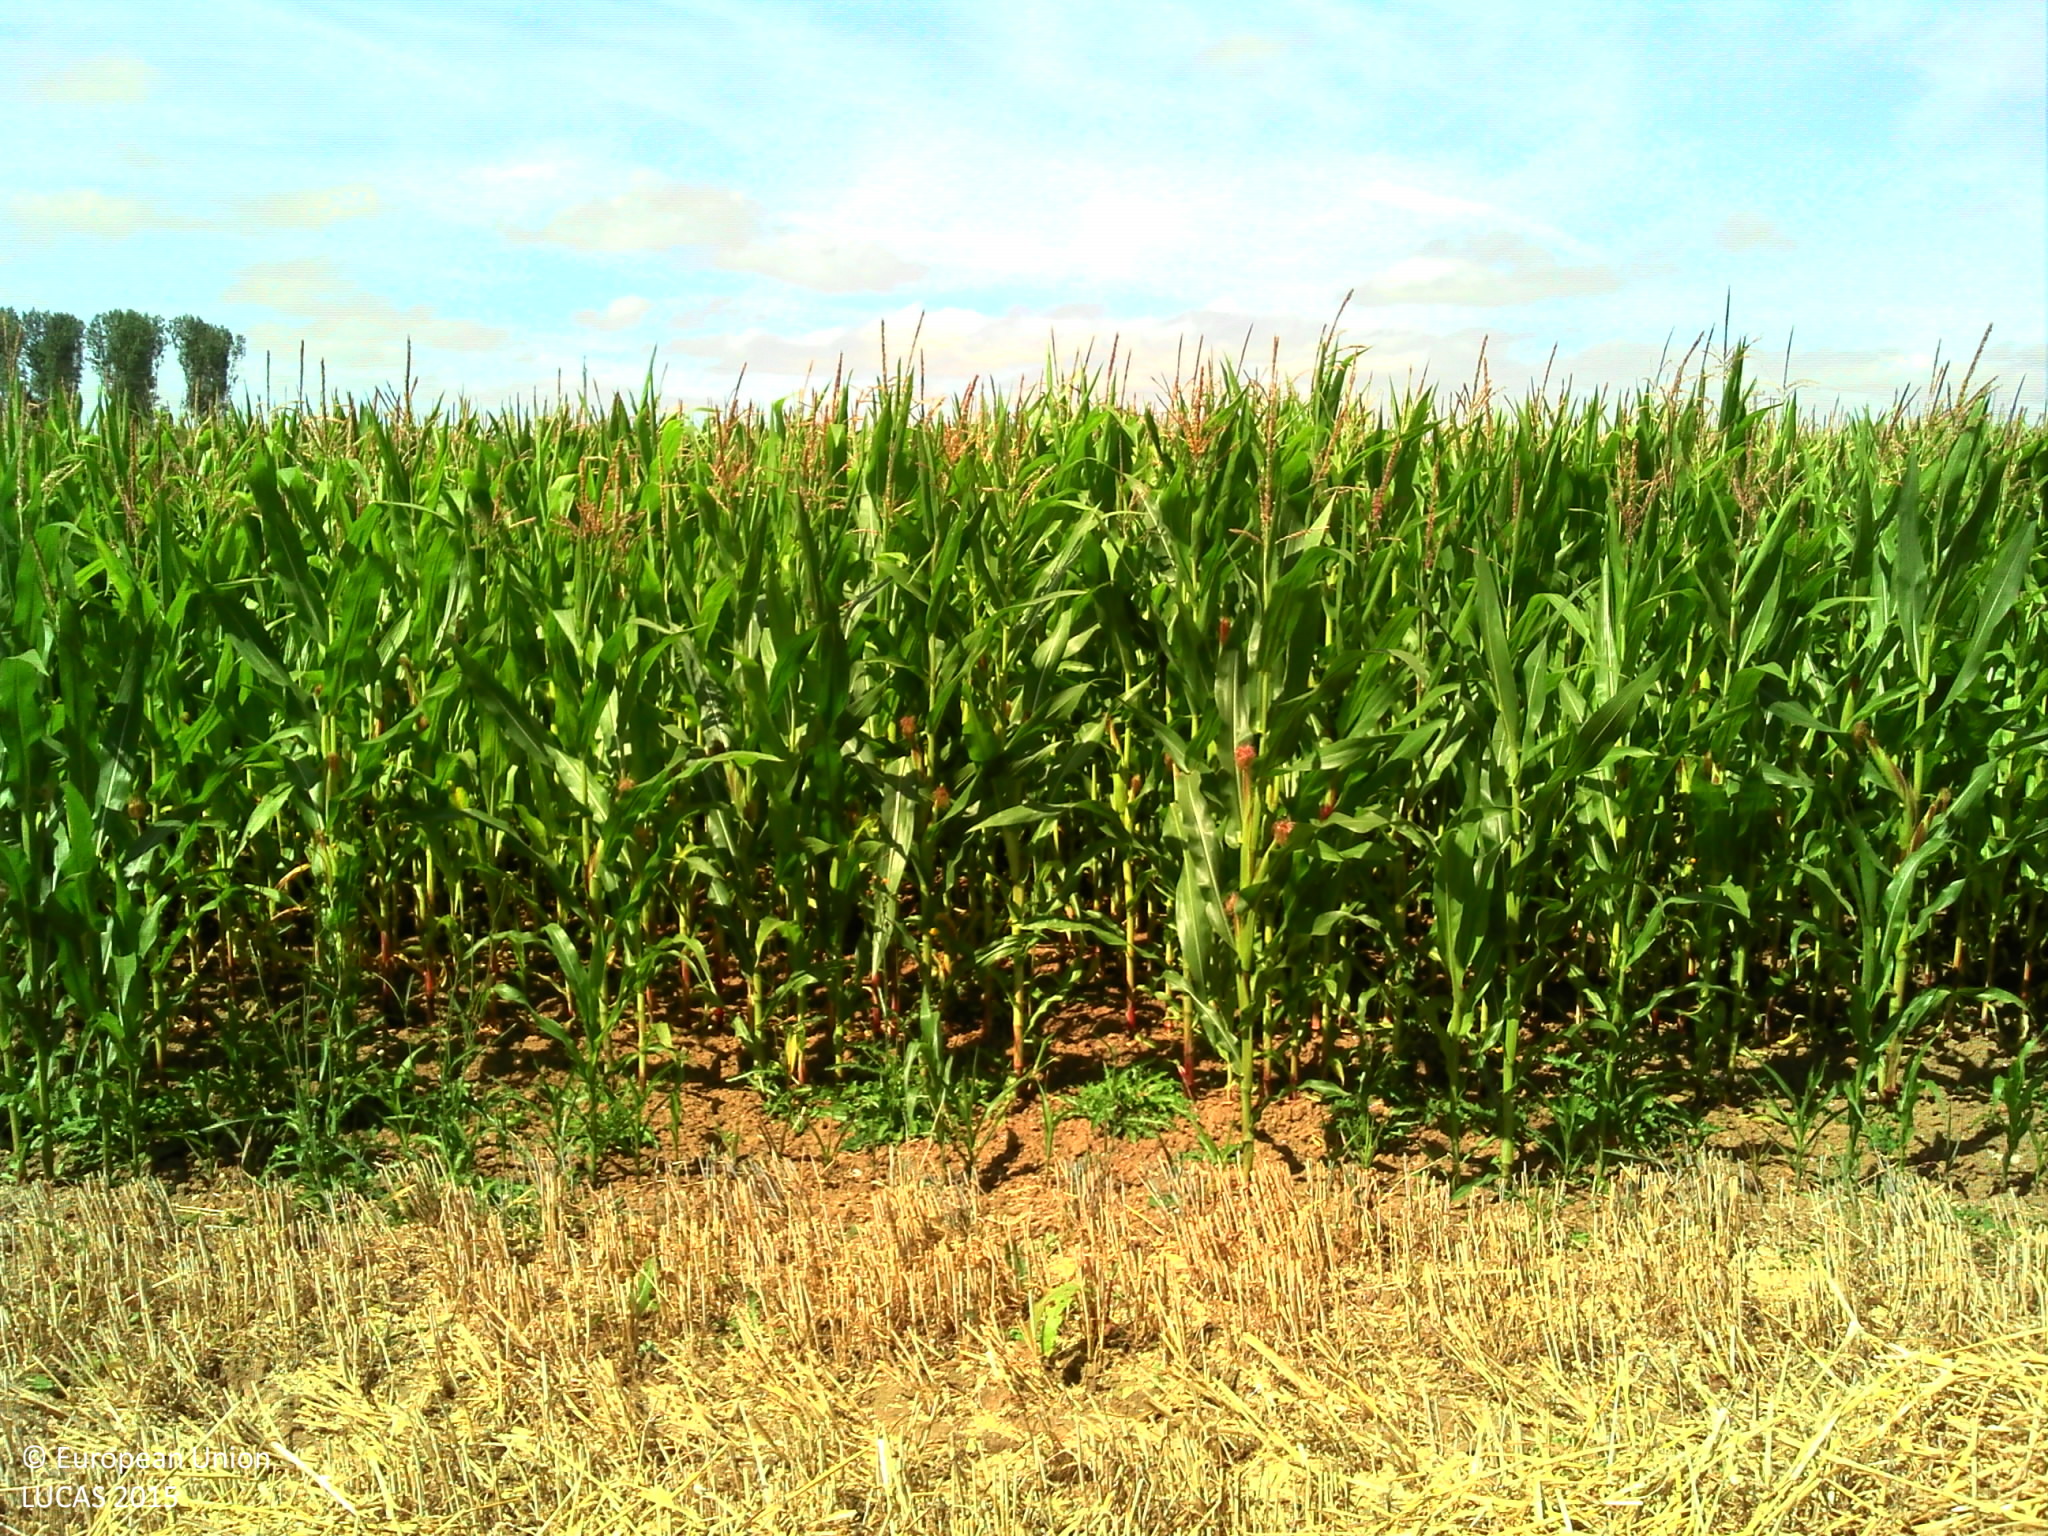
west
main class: Cropland
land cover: Common wheat
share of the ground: > 75 %
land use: Agriculture (excluding fallow land and kitchen gardens)
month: August
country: FR
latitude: 50.6560
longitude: 2.4476
